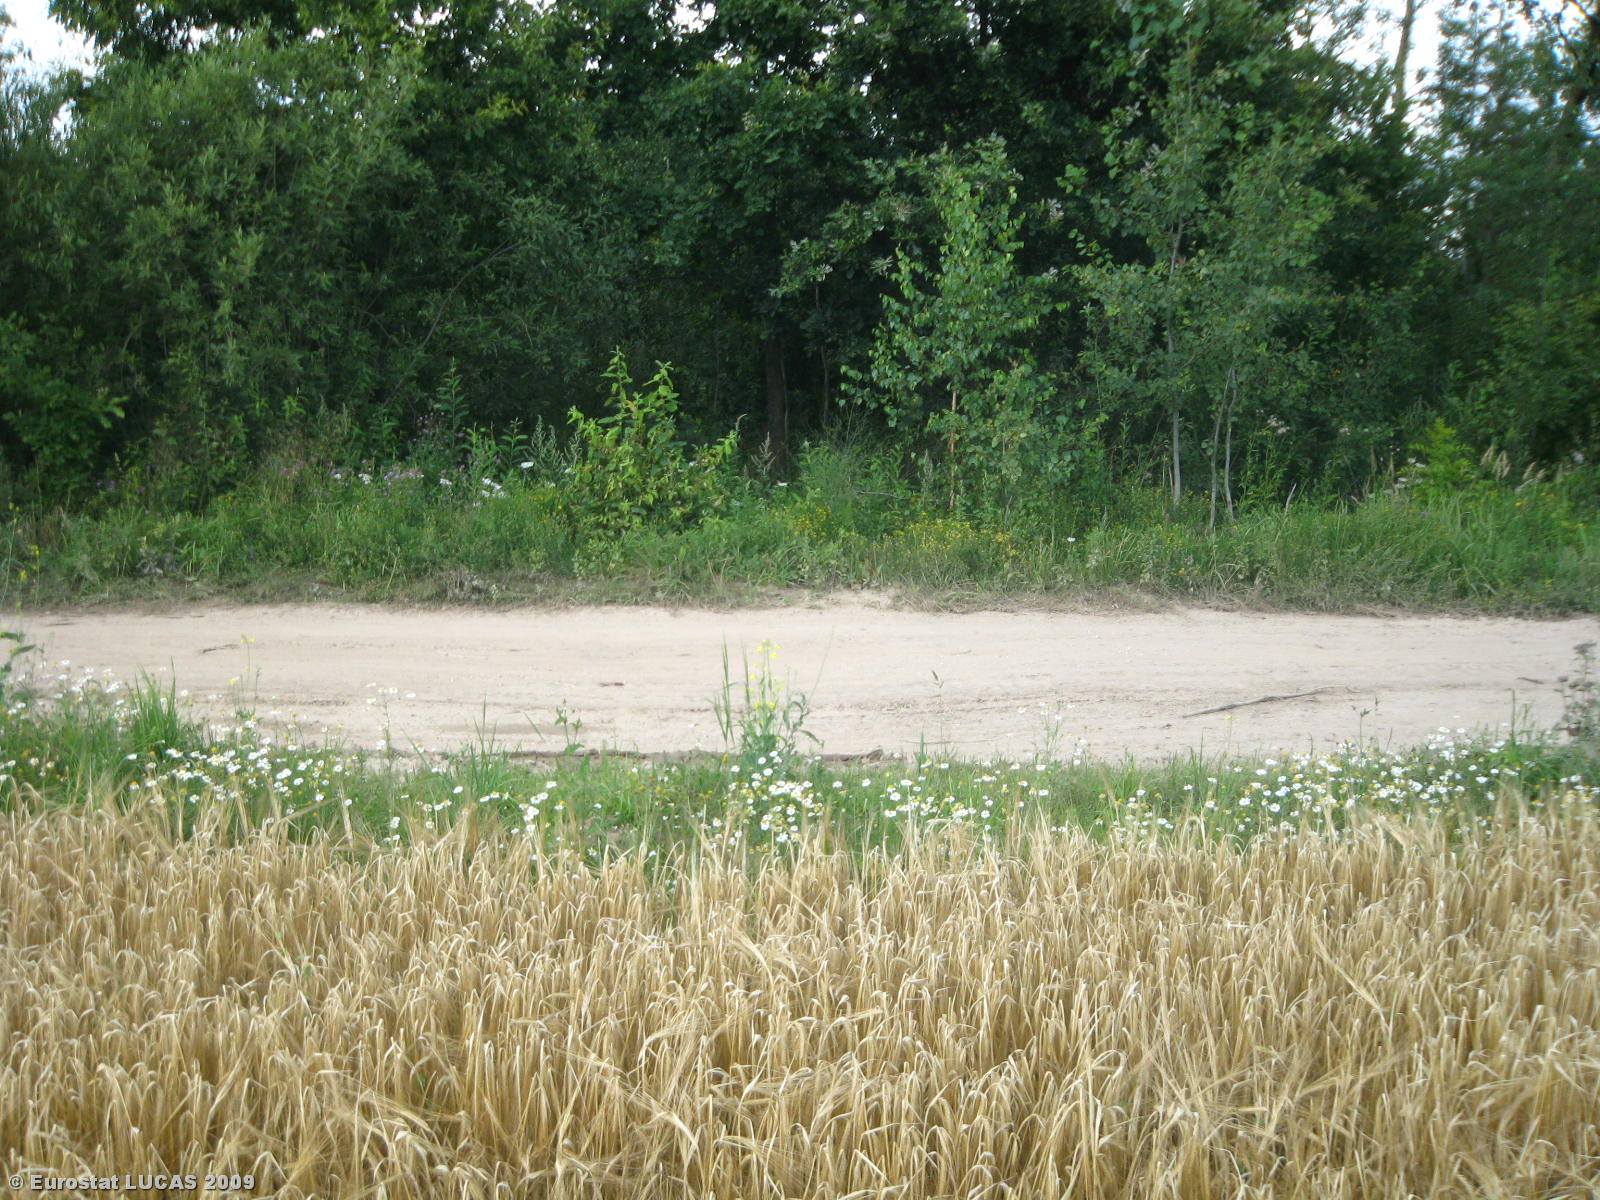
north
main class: Cropland
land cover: Barley
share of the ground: > 75 %
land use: Agriculture (excluding fallow land and kitchen gardens)
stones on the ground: < 10 %
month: August
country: LT
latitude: 55.3363
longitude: 23.7209
